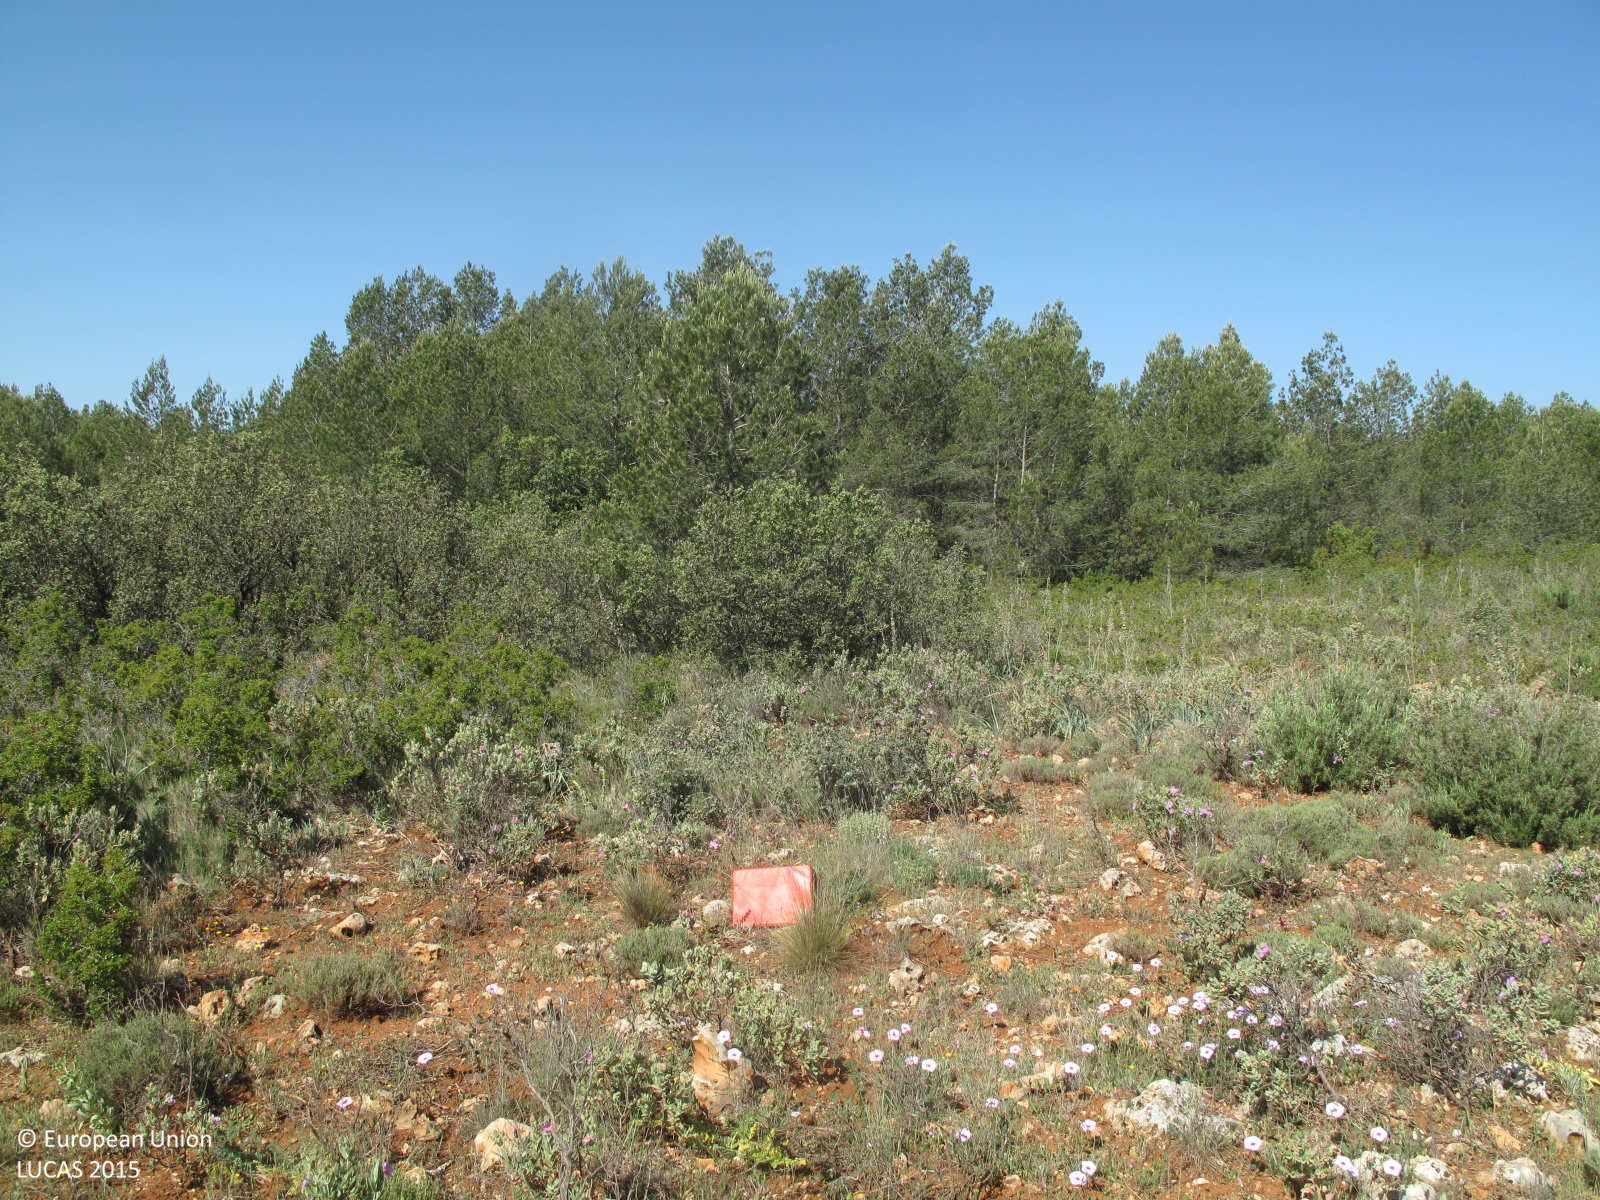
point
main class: Shrubland
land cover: Shrubland with sparse tree cover
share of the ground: 50 - 75 %
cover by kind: shrubs 55 %, herbaceous plants 20 %, consolidated bare surface 20 %, coniferous forest trees 5 %
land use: Semi-natural and natural areas not in use
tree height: < 5 m
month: May
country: ES
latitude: 38.9569
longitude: -0.8064
